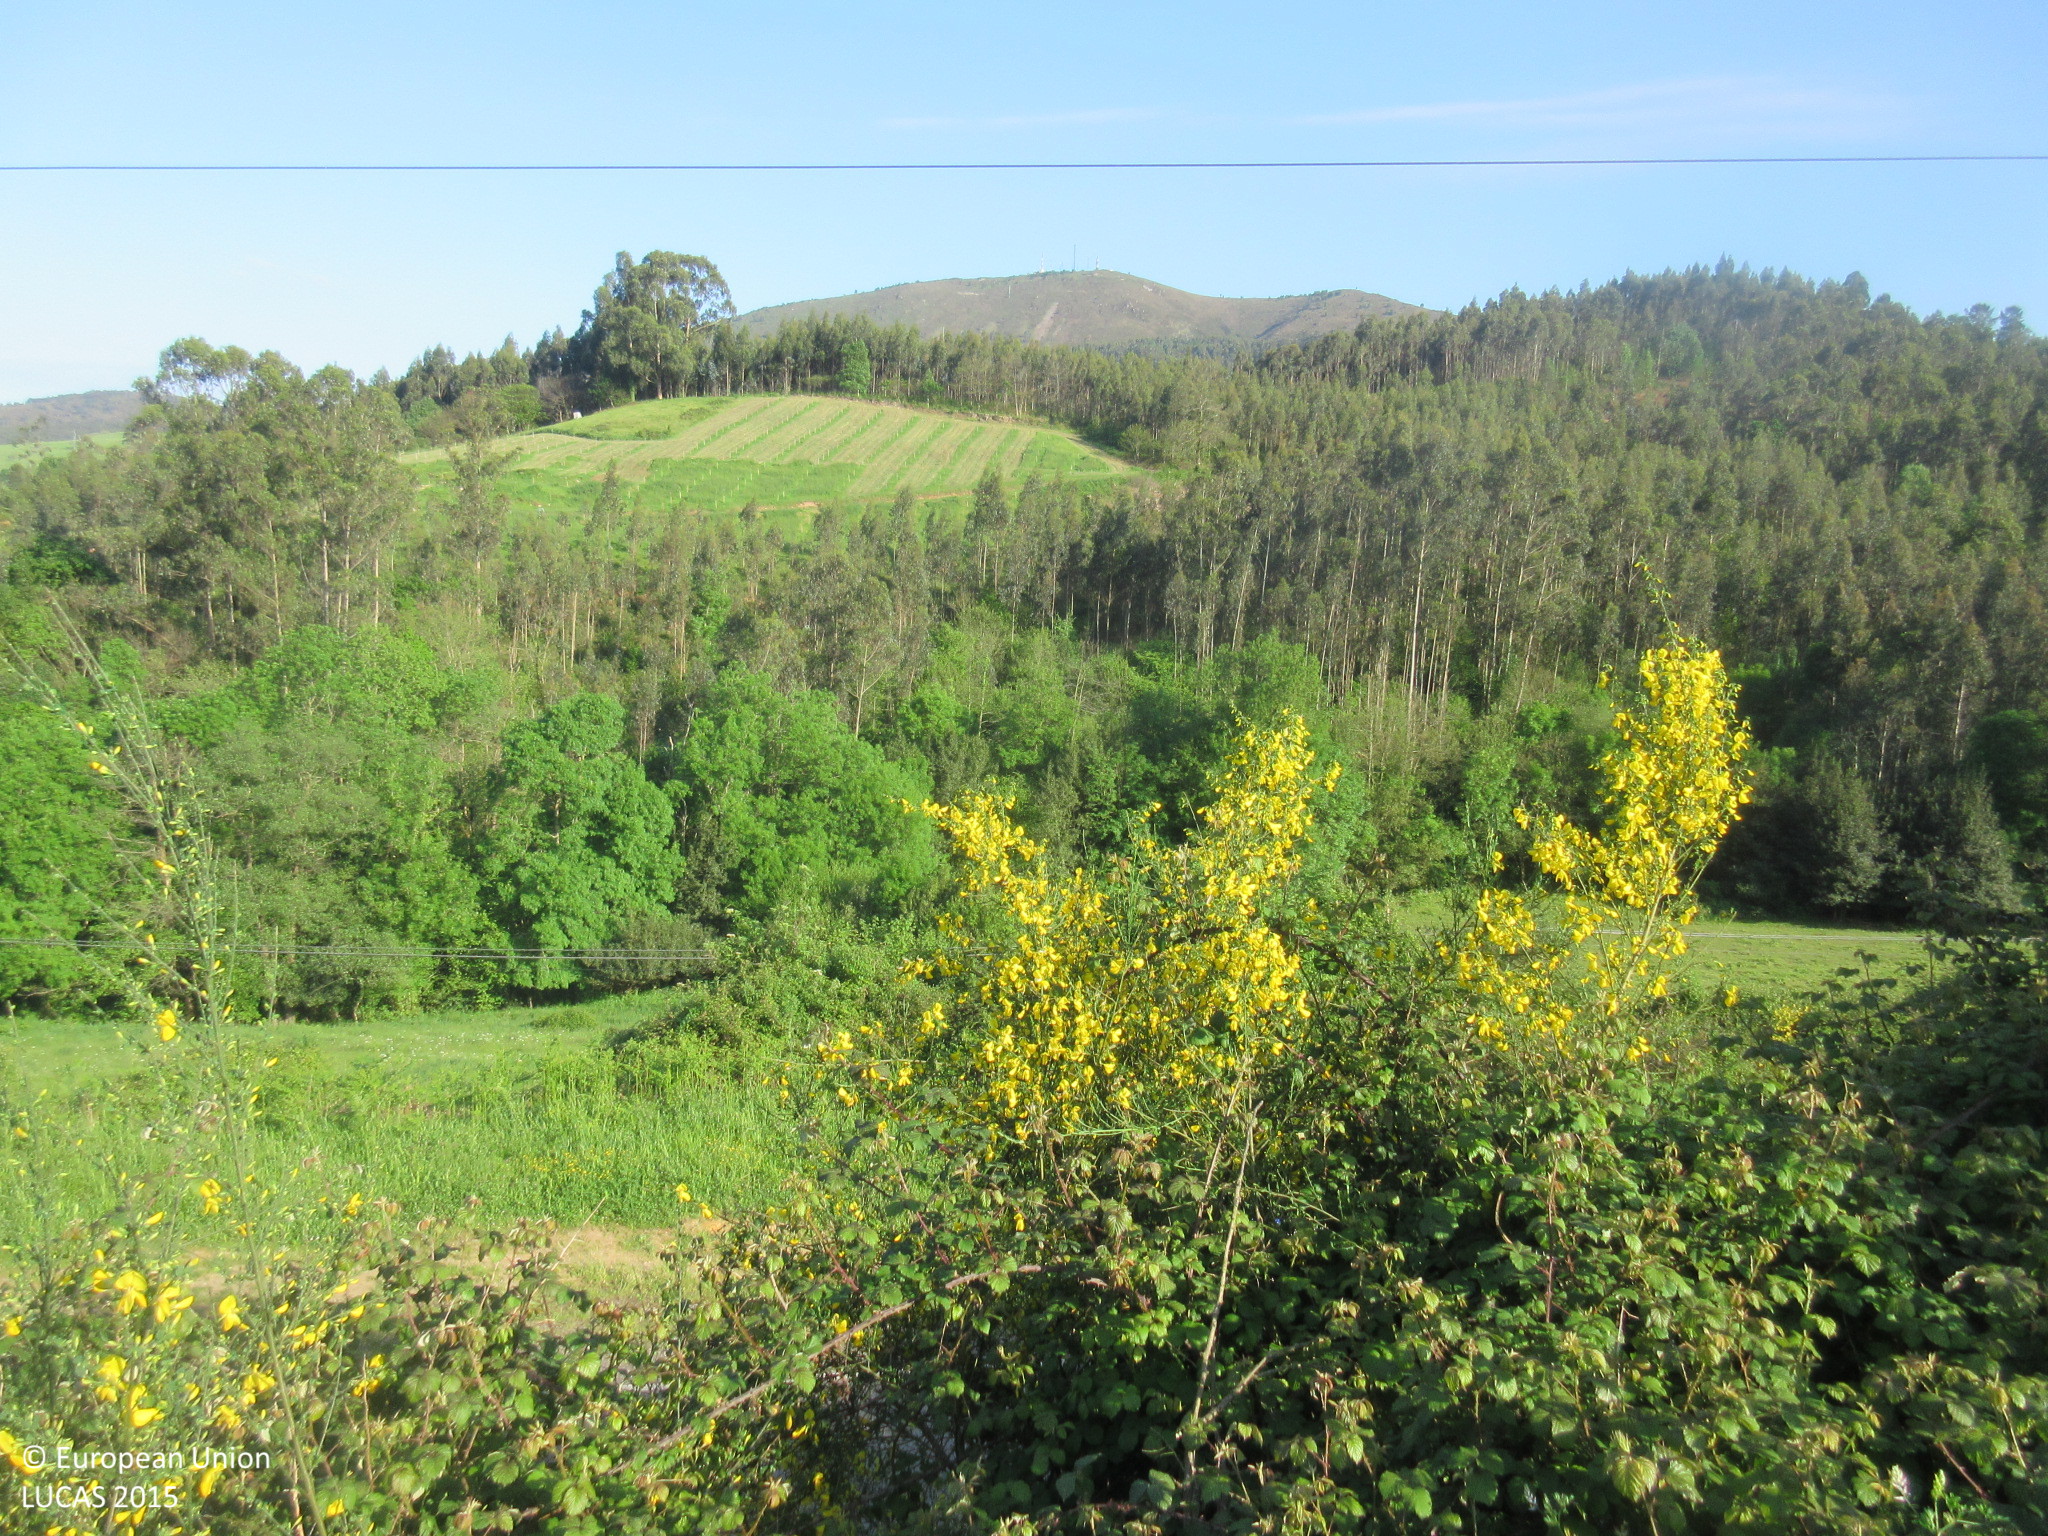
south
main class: Grassland
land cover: Grassland with sparse tree/shrub cover
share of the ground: > 75 %
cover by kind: herbaceous plants 95 %, broadleaved forest trees 5 %
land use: Agriculture (excluding fallow land and kitchen gardens)
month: May
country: ES
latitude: 43.5093
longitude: -5.9618
